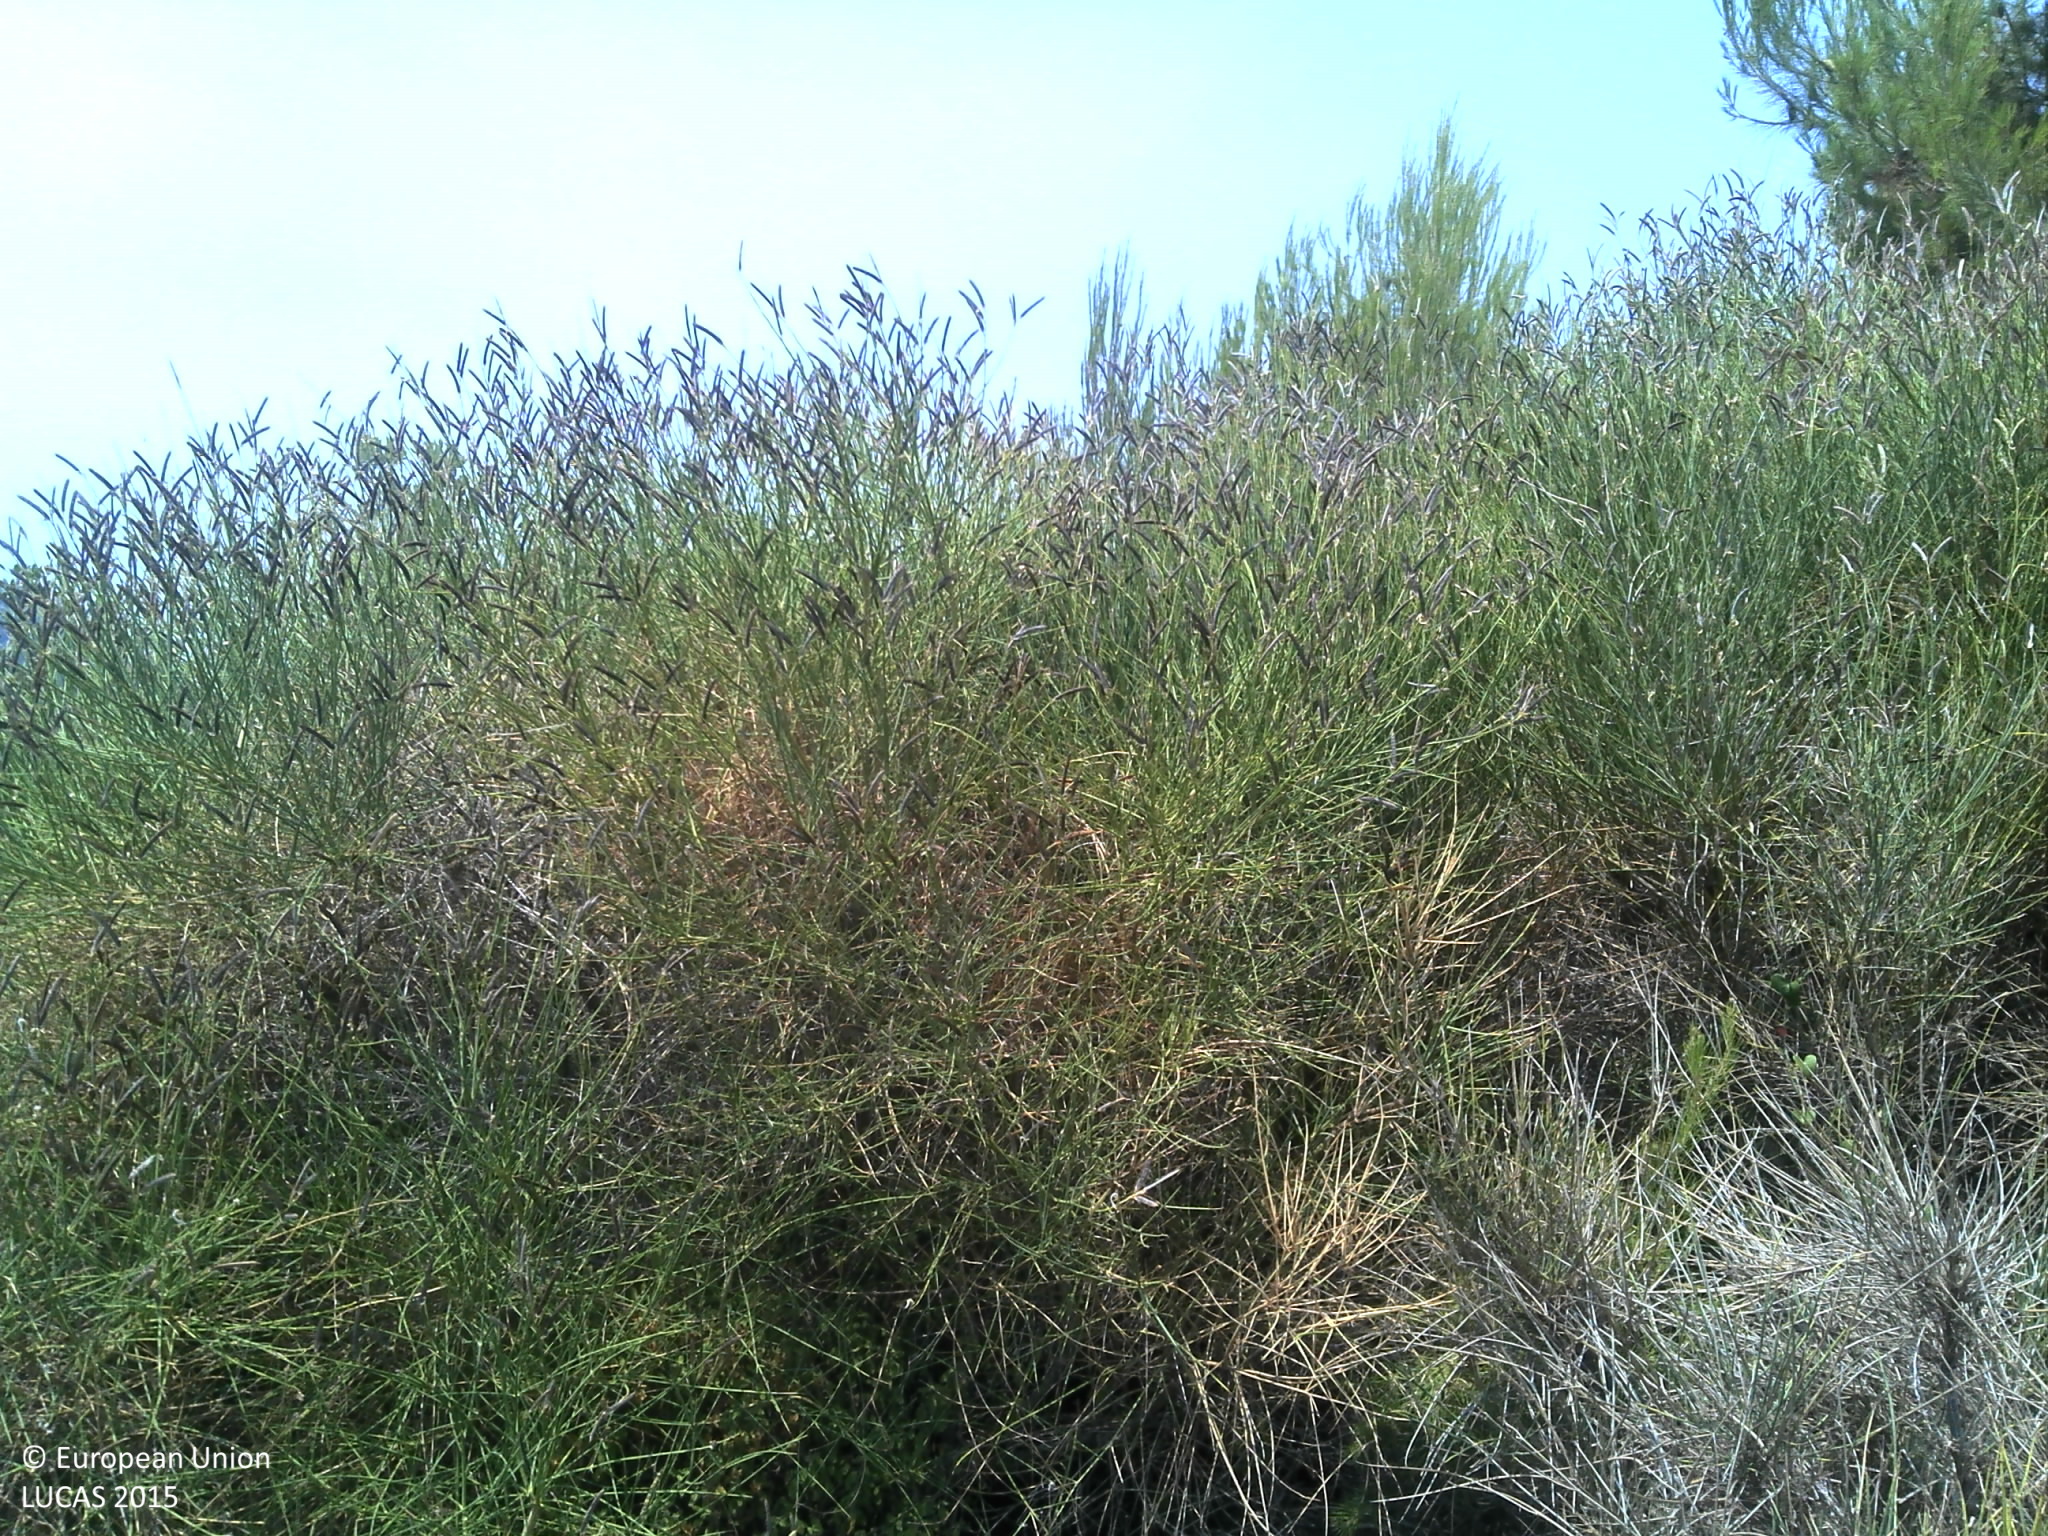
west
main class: Cropland
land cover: Vineyards
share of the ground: > 75 %
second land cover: Grassland without tree/shrub cover
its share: > 75 %
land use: Agriculture (excluding fallow land and kitchen gardens)
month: July
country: HR
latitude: 42.8854
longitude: 17.4709
